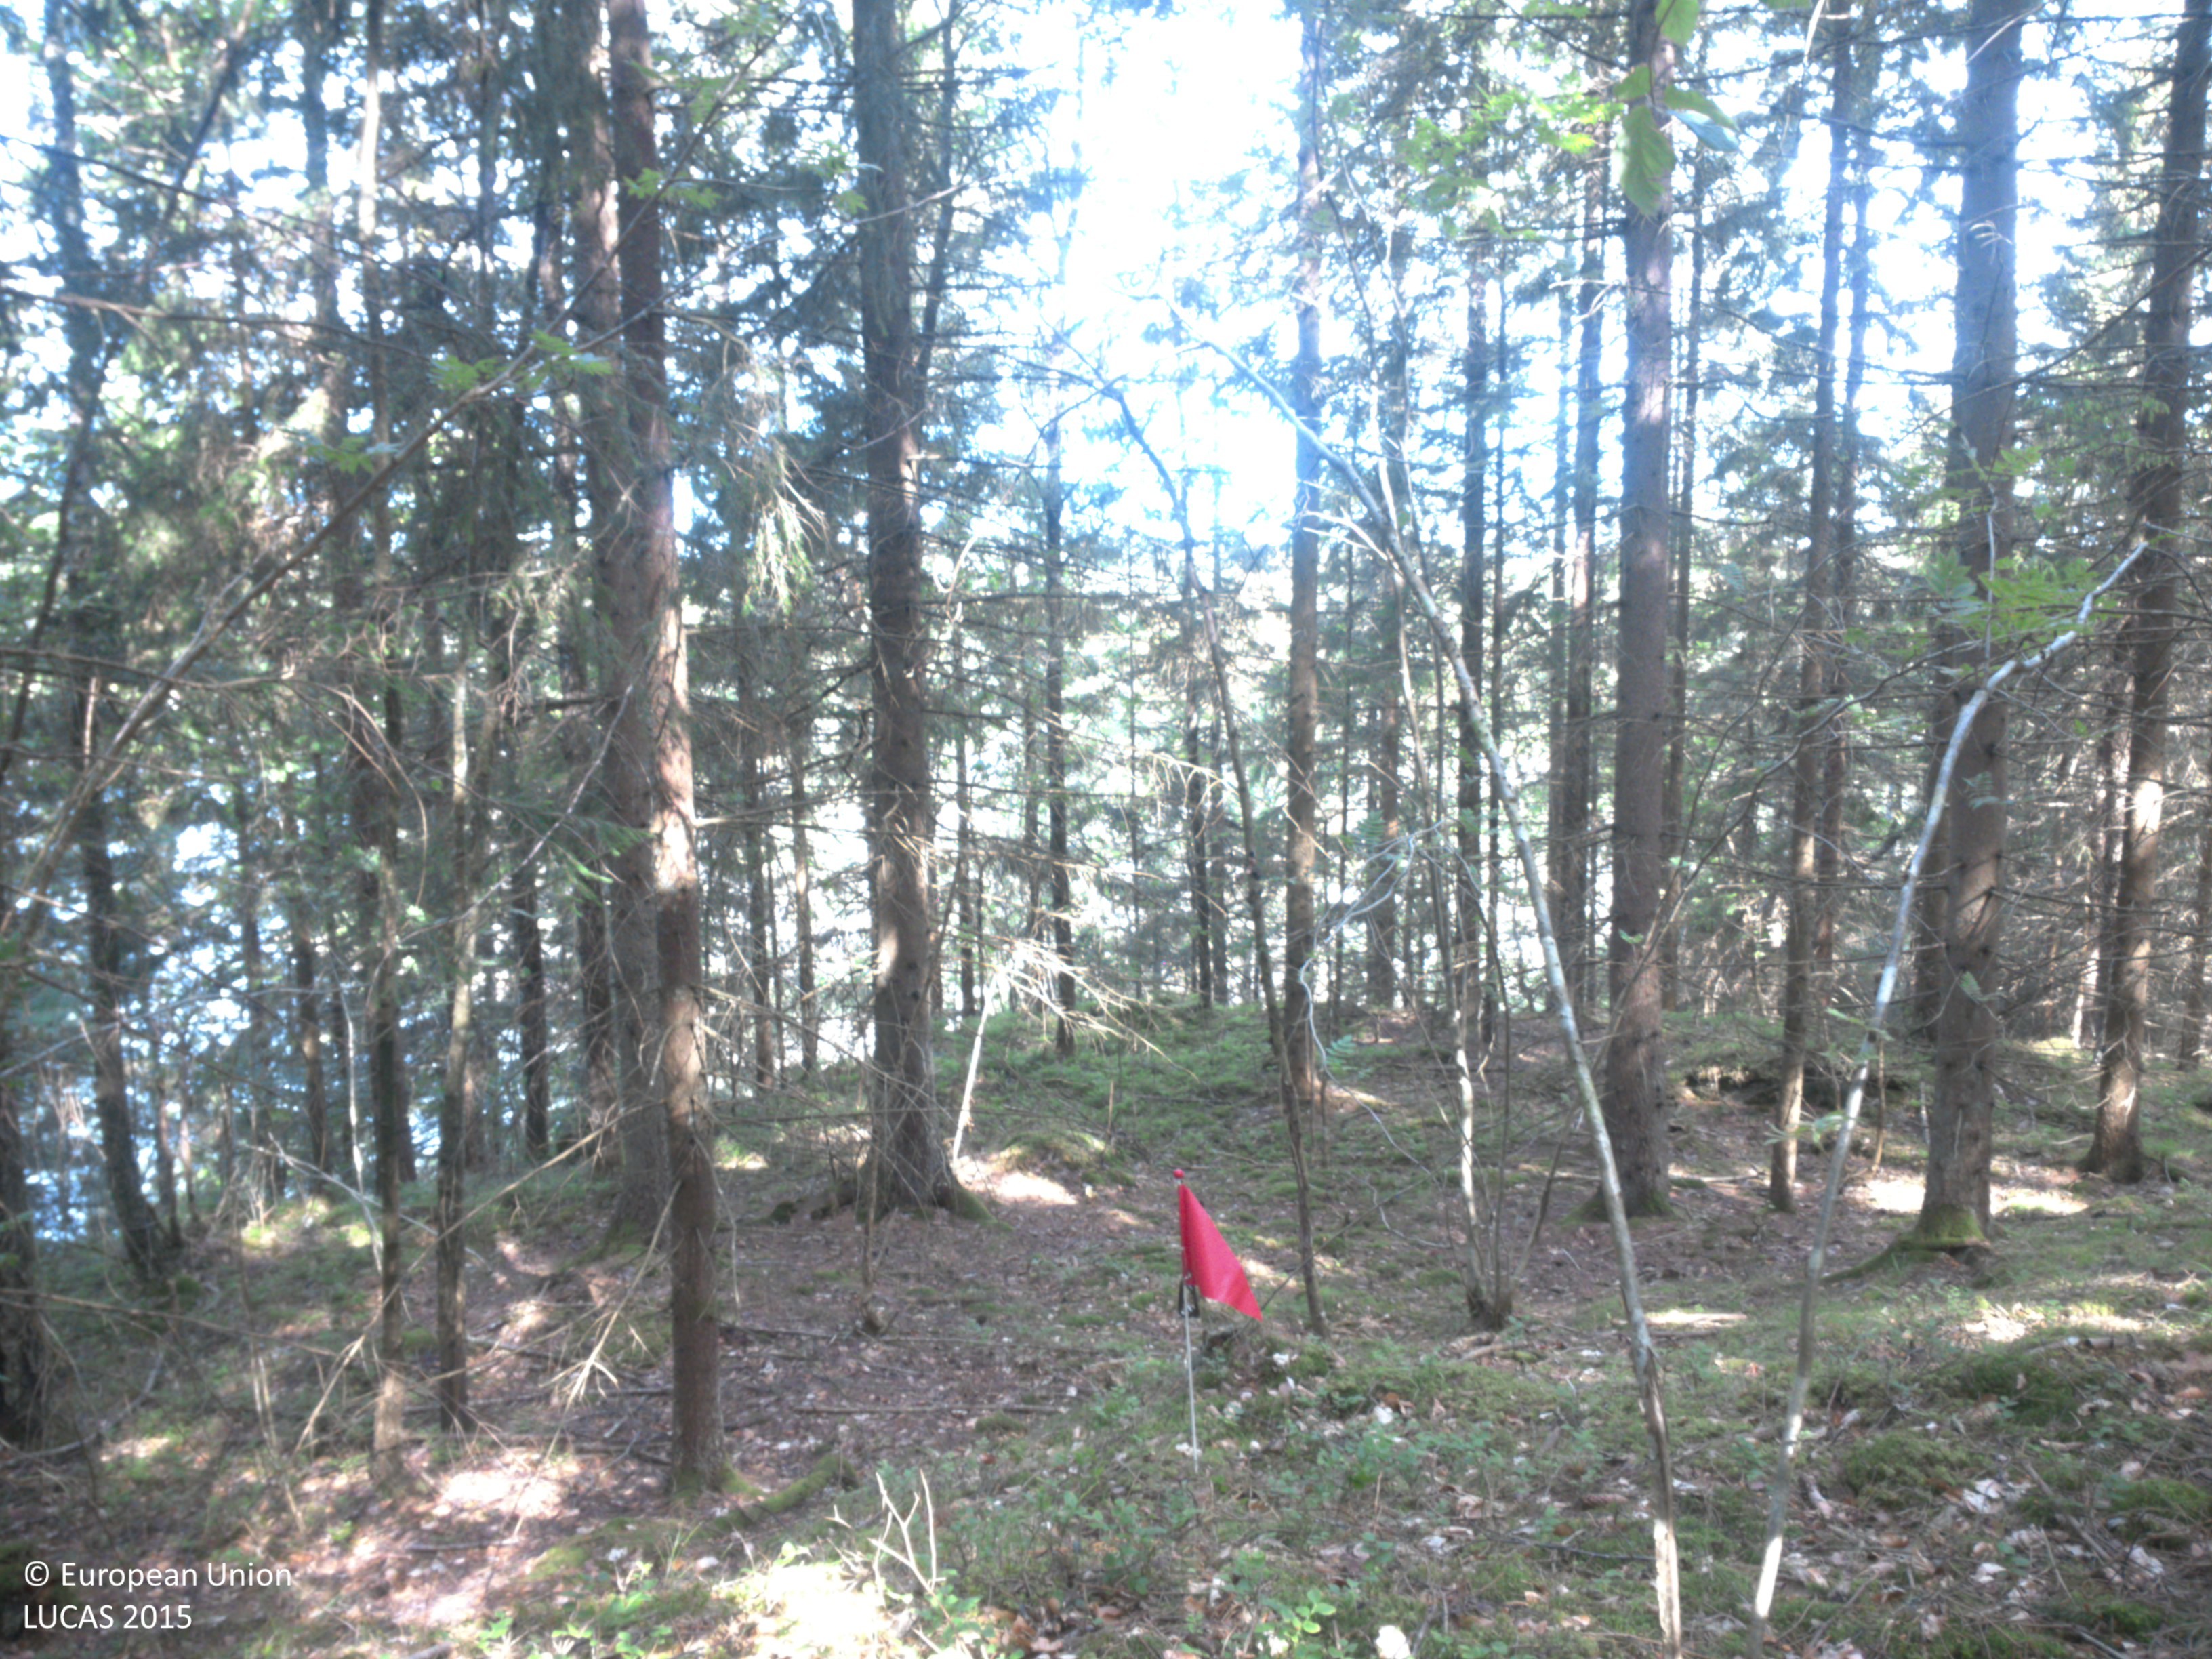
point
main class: Woodland
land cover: Spruce dominated mixed woodland
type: boreal forest
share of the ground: > 75 %
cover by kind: coniferous forest trees 55 %, broadleaved forest trees 25 %, lichens and mosses 20 %
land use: Forestry
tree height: > 5 m
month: June
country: SE
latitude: 58.4439
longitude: 11.5899
